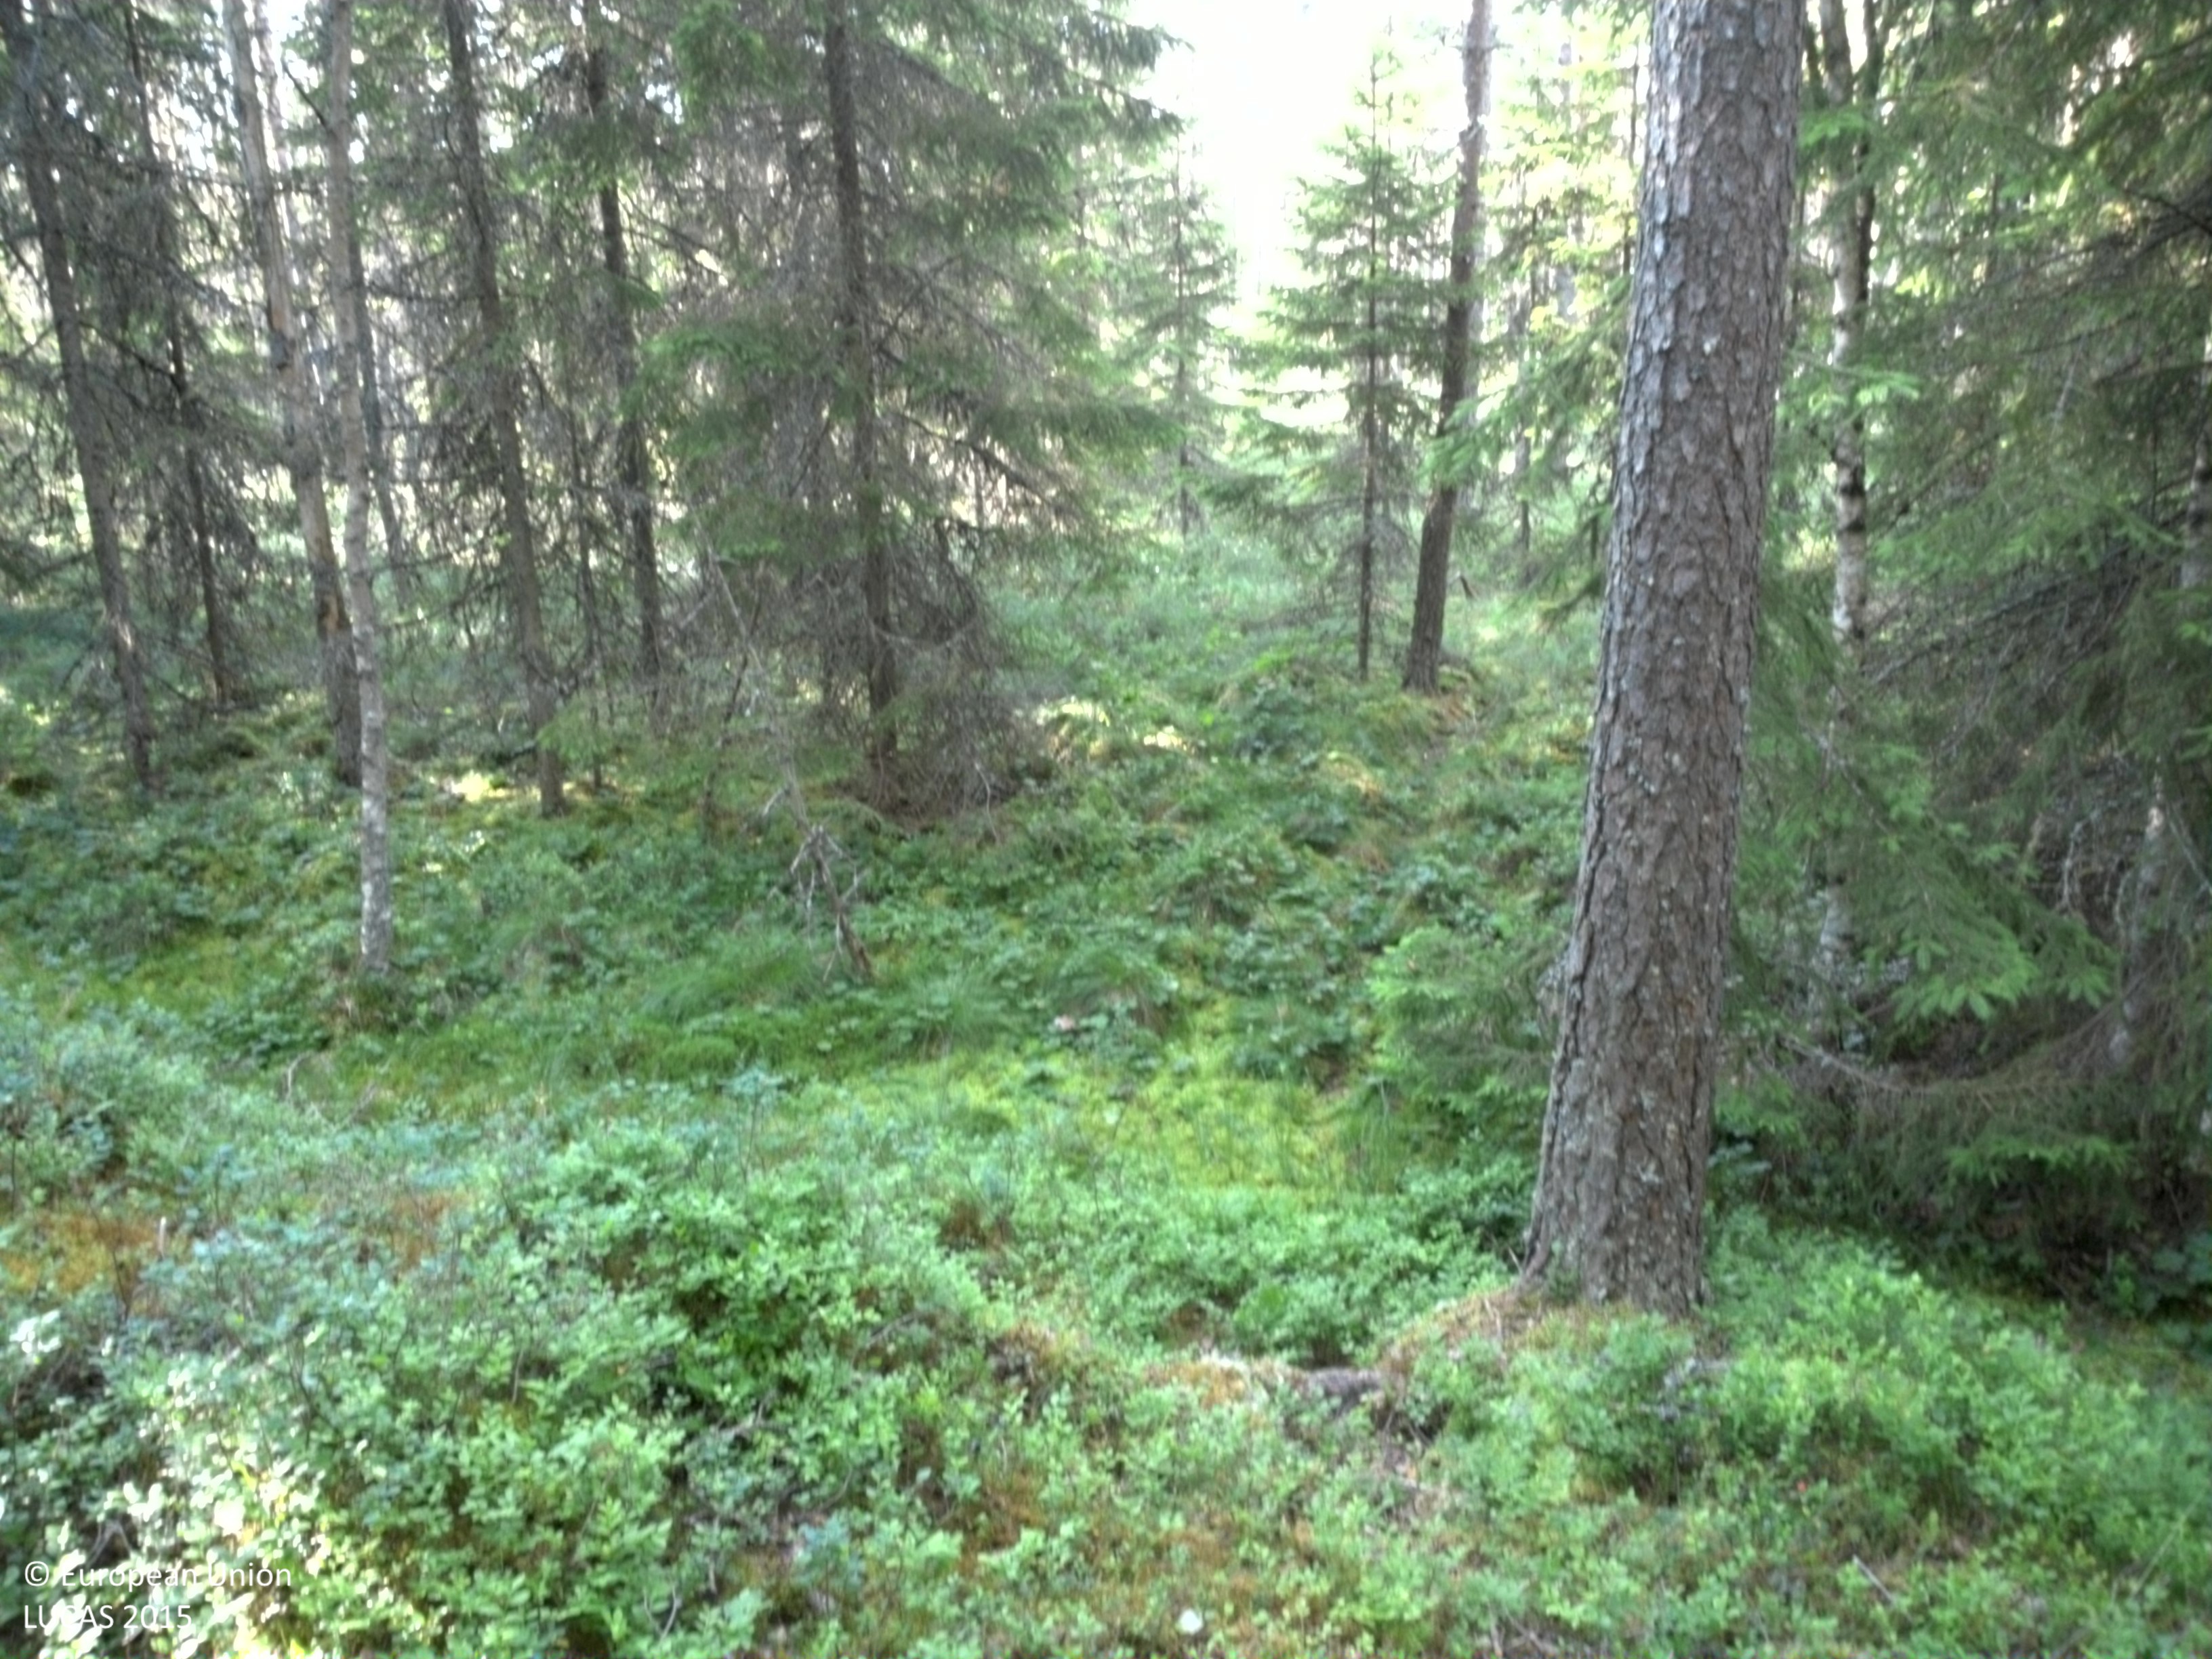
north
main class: Woodland
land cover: Pine dominated coniferous woodland
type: boreal forest
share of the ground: 50 - 75 %
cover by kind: coniferous forest trees 70 %, lichens and mosses 20 %, shrubs 10 %
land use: Forestry
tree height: > 5 m
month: July
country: SE
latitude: 57.7138
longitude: 14.4434
